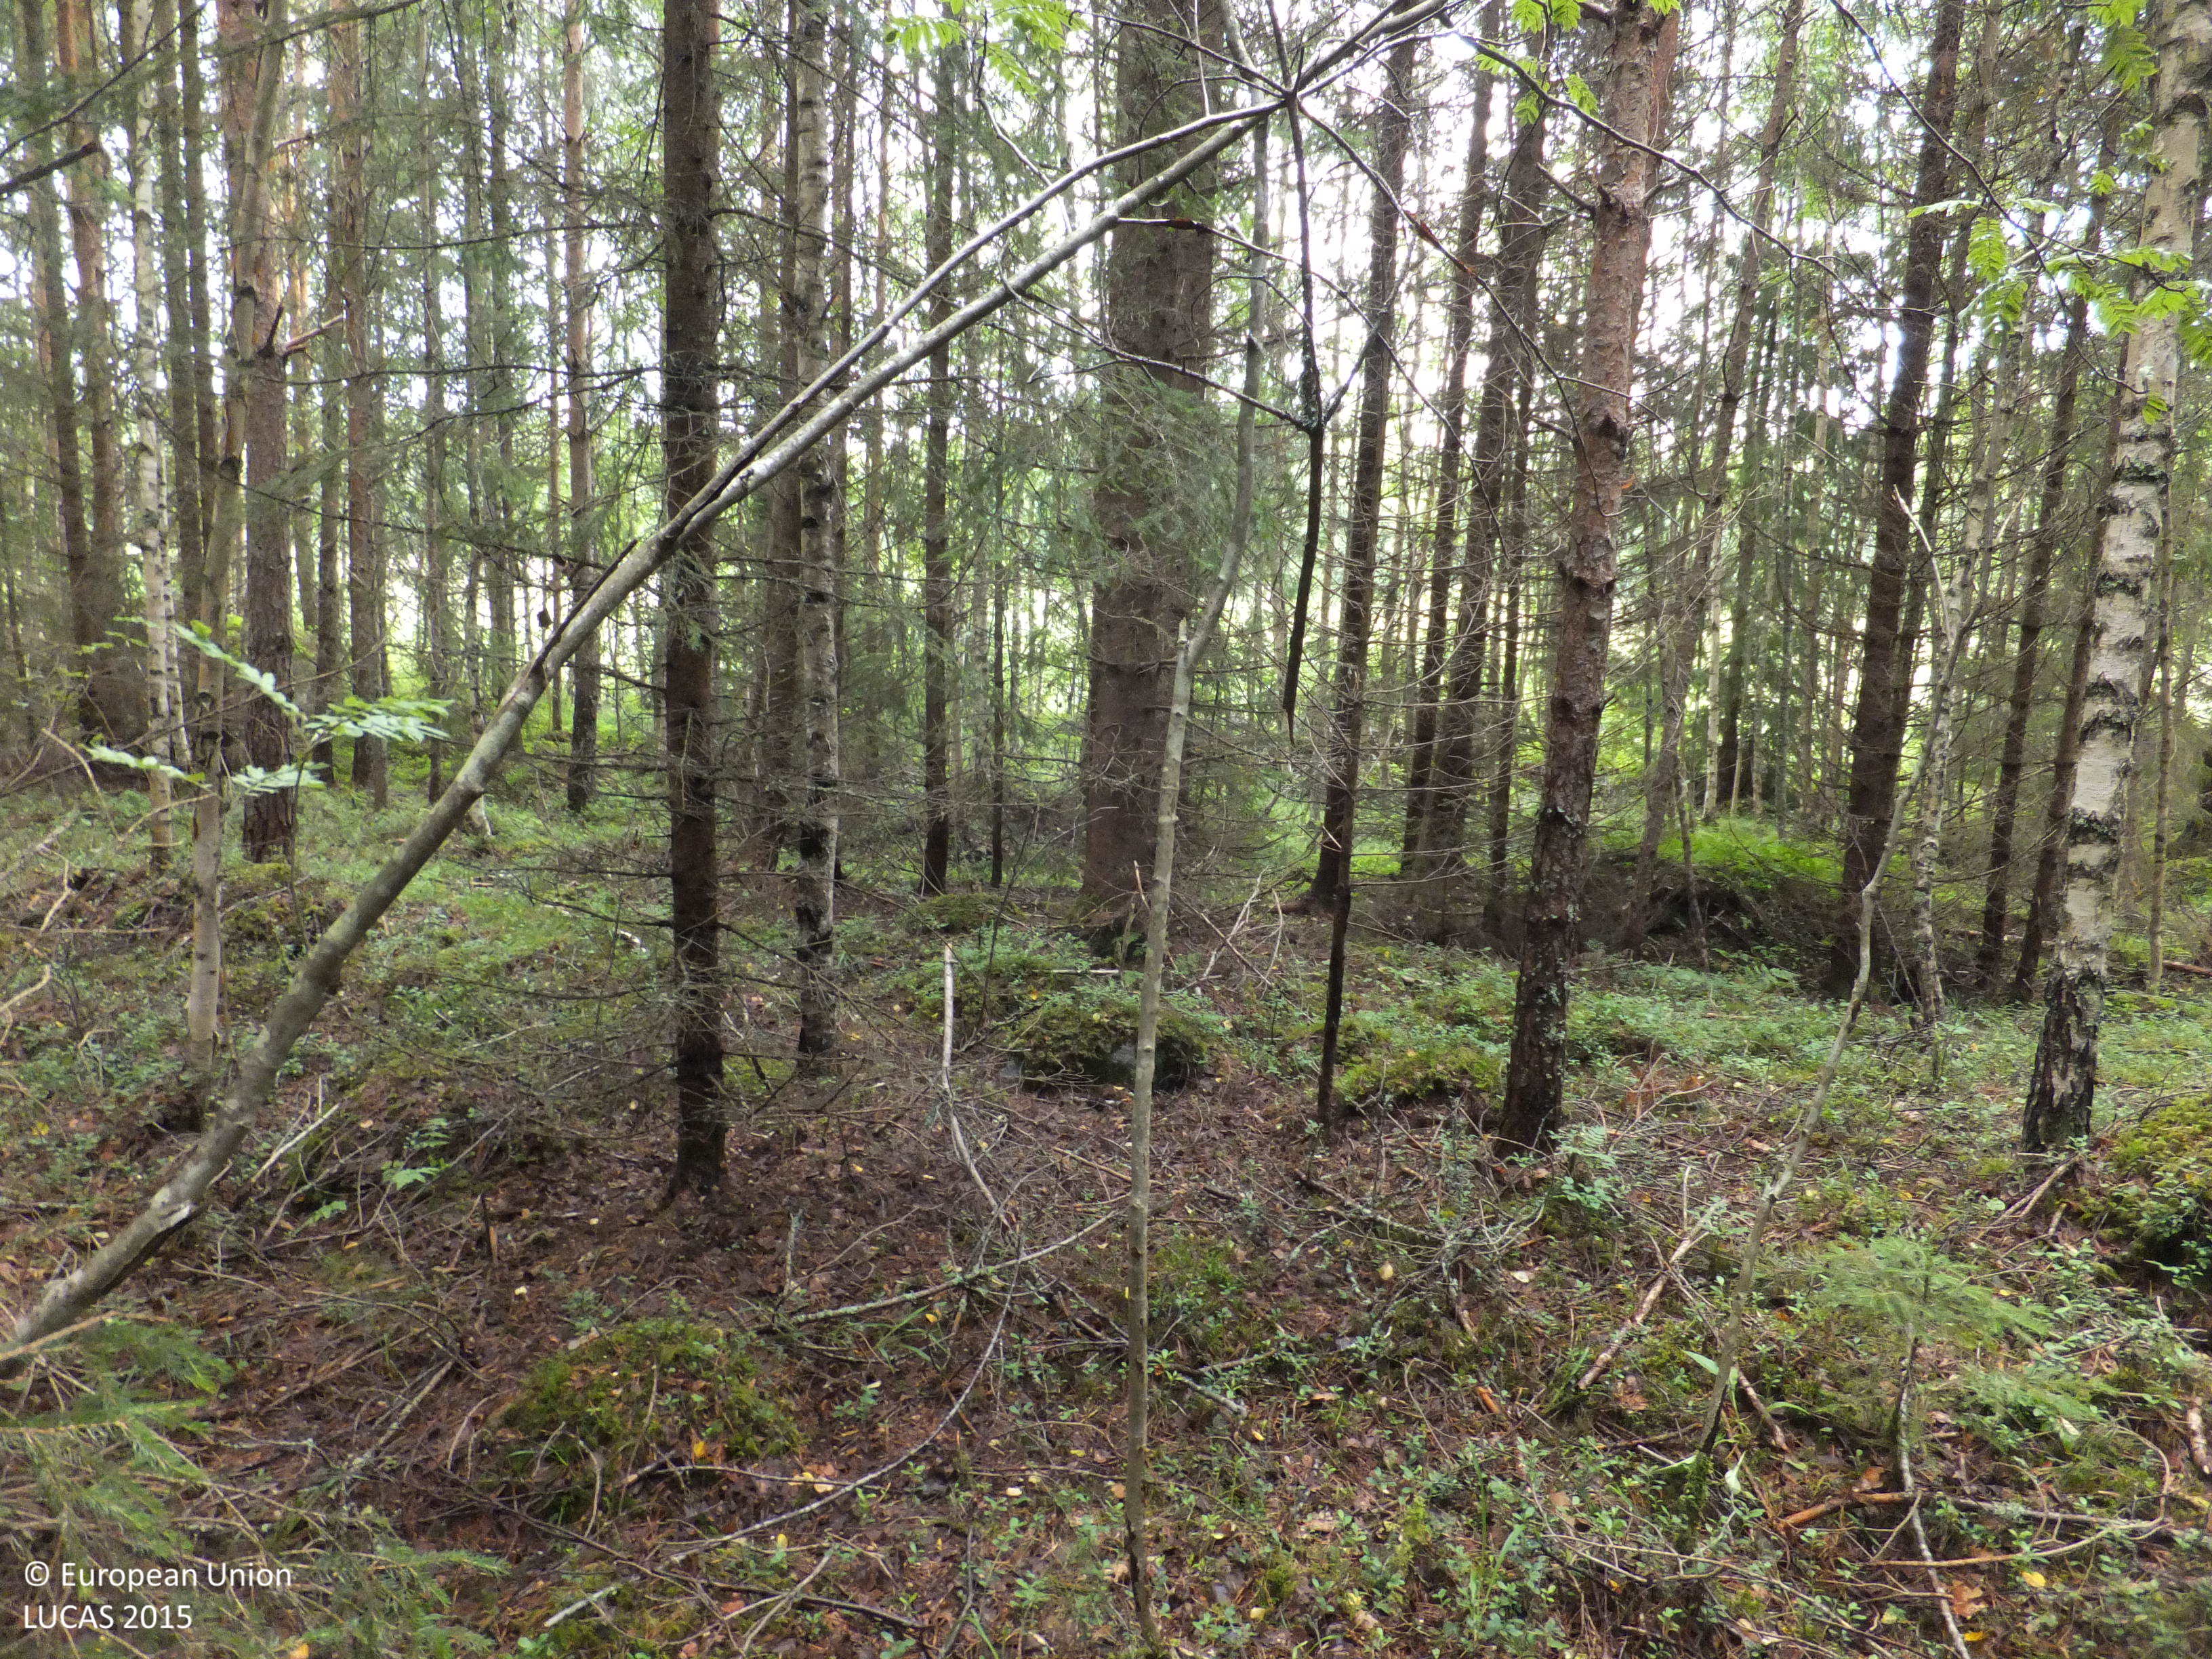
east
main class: Woodland
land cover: Other mixed woodland
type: boreal forest
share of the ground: > 75 %
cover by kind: broadleaved forest trees 45 %, coniferous forest trees 40 %, shrubs 5 %, herbaceous plants 5 %, lichens and mosses 5 %
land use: Forestry
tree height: > 5 m
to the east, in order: Other mixed woodland; Ditches and canals; Grassland without tree/shrub cover; Ditches and canals; Grassland without tree/shrub cover; Ditches and canals; Grassland without tree/shrub cover; Ditches and canals; Barley; Ditches and canals; Spruce dominated mixed woodland
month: July
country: FI
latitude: 63.0387
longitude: 21.6057
